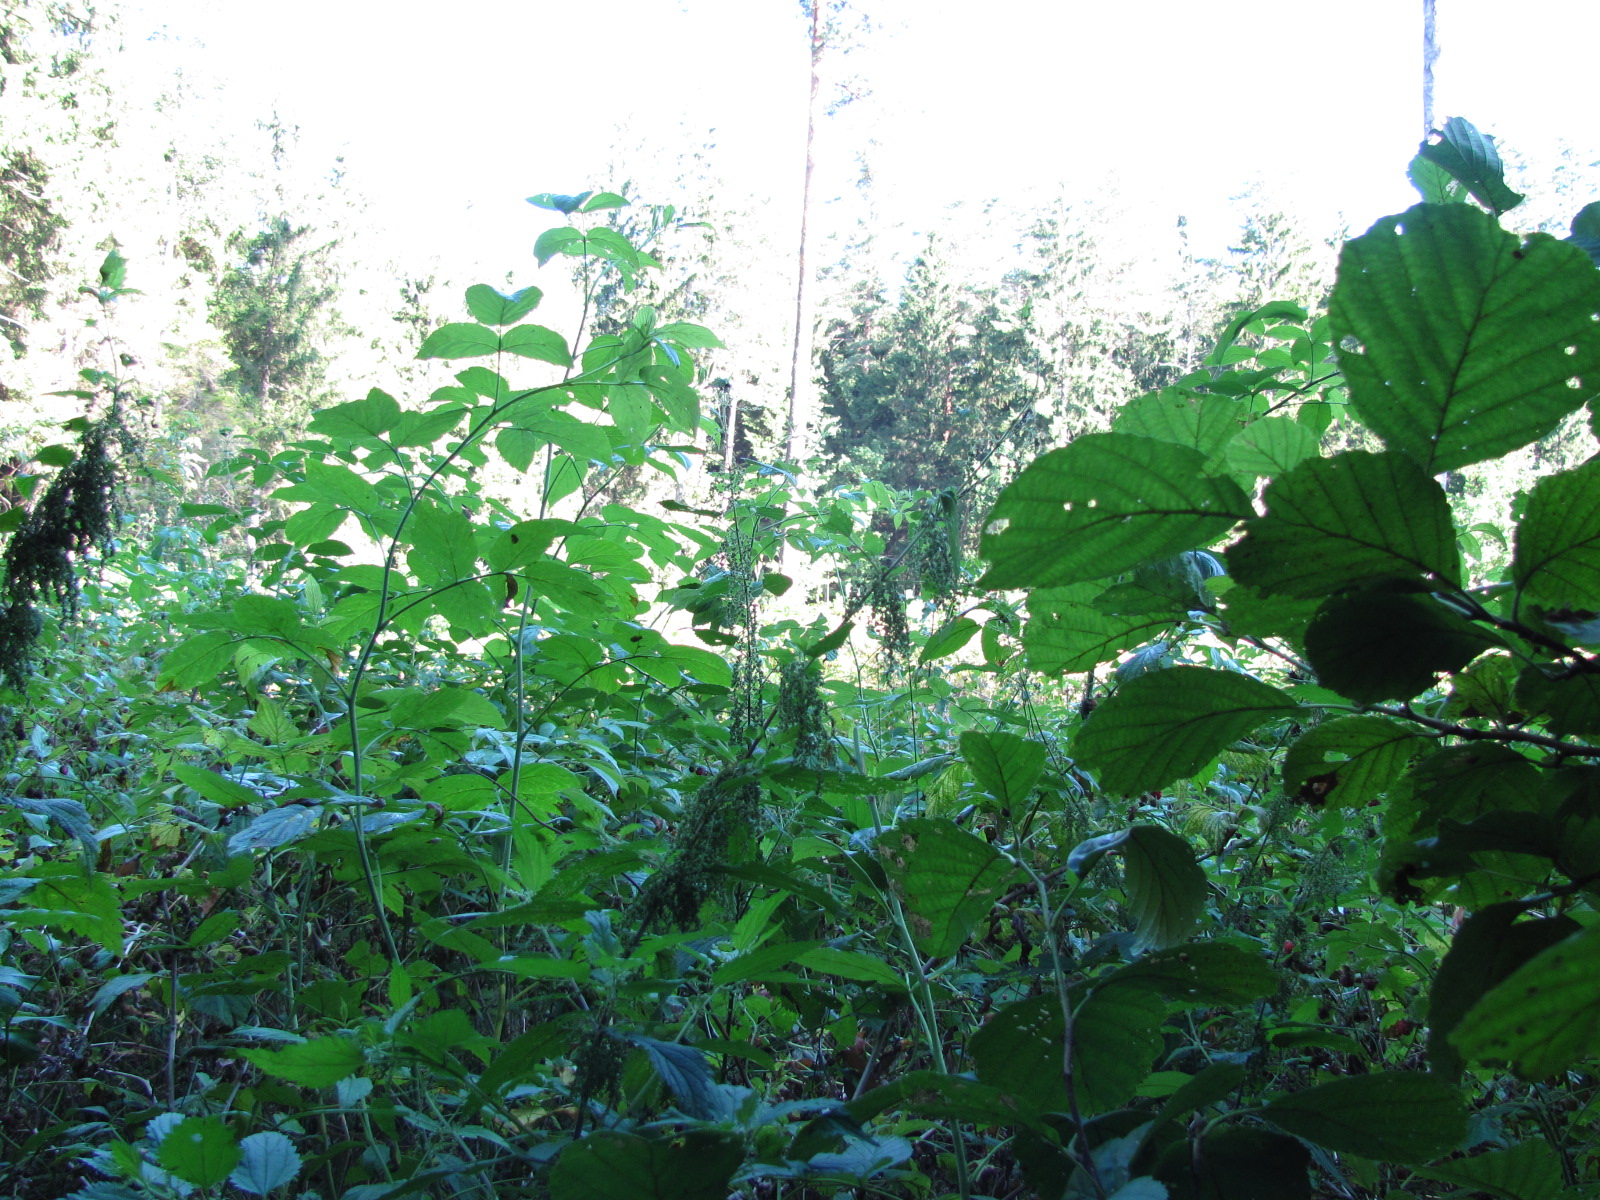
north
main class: Woodland
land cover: Broadleaved woodland
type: non-riverine alder, birch or aspen forest
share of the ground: > 75 %
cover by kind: broadleaved forest trees 85 %, herbaceous plants 15 %
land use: Forestry
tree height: > 5 m
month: August
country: LV
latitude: 56.6688
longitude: 23.9037
